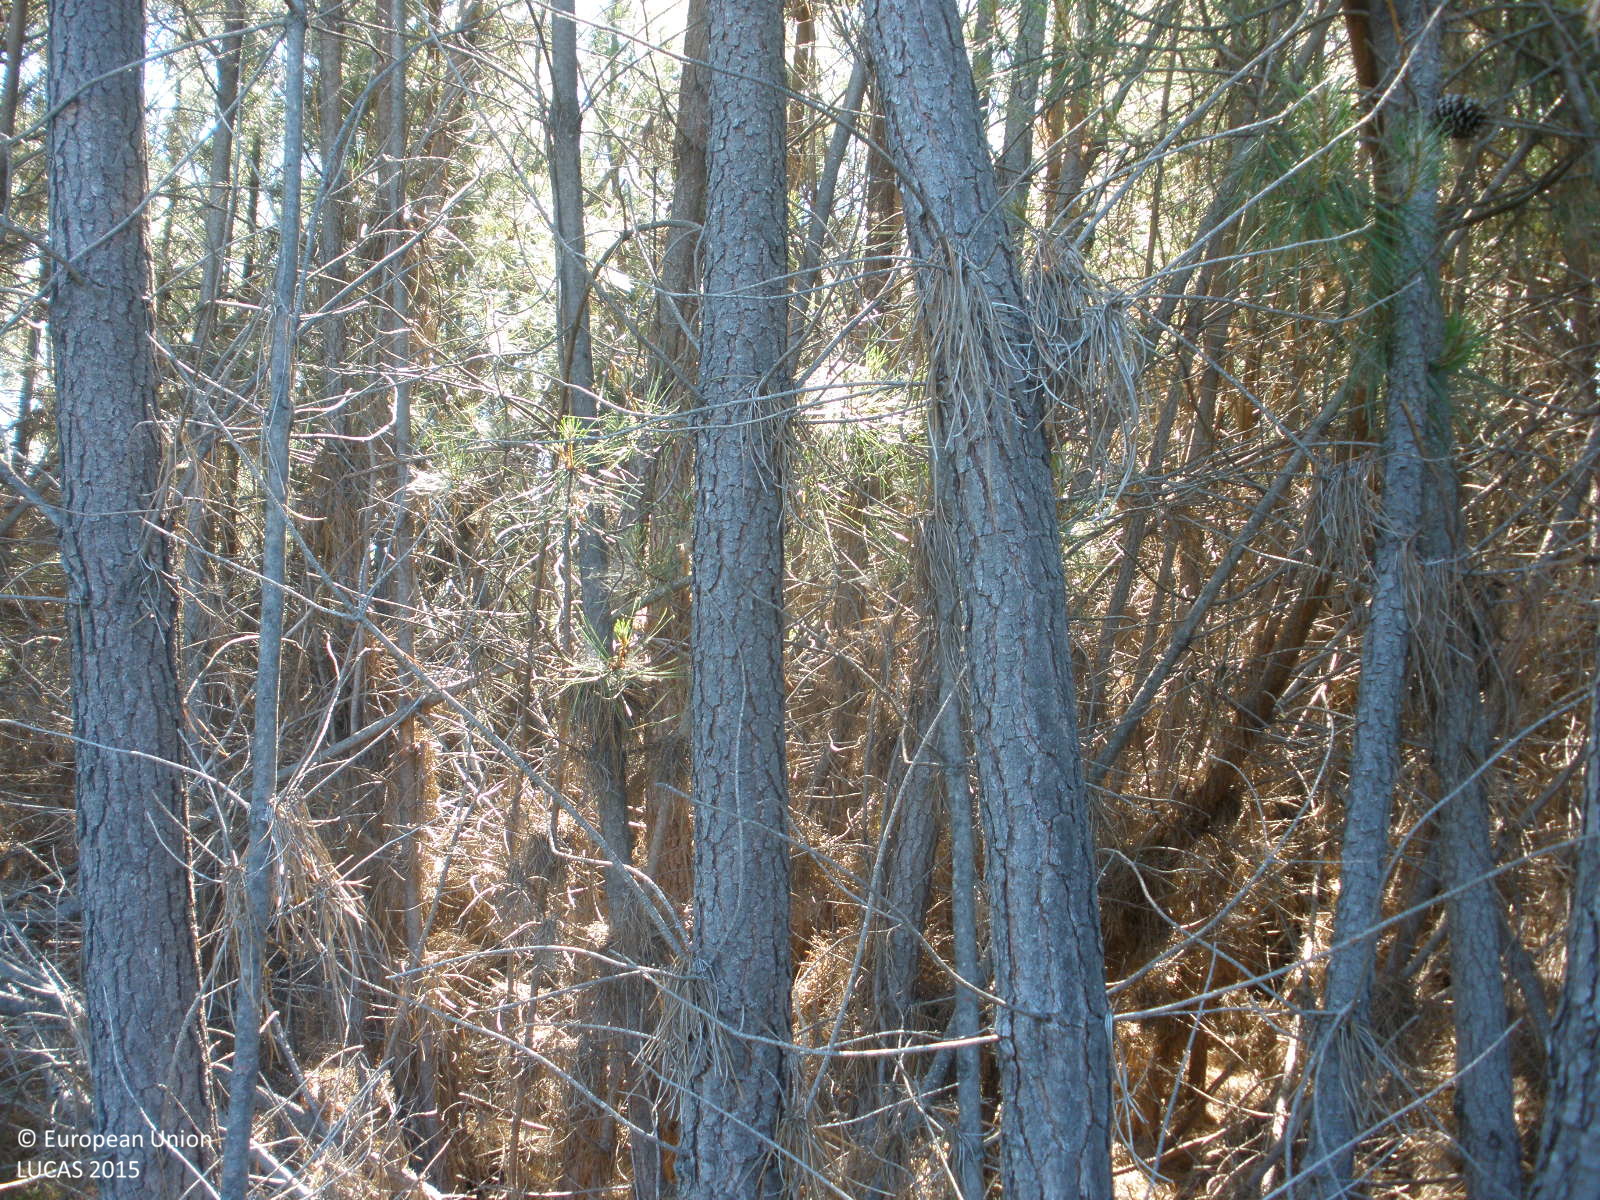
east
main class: Woodland
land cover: Pine dominated coniferous woodland
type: coniferous forest of the mediterranean region
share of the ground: > 75 %
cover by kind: coniferous forest trees 90 %, shrubs 10 %
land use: Forestry
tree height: > 5 m
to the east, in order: Pine dominated coniferous woodland; Shrubland without tree cover; Tracks; Shrubland with sparse tree cover; Permanent crops (only in case pi); Broadleaved woodland; Grassland without tree/shrub cover; Electric lines; Grassland without tree/shrub cover; Tracks; Pine dominated coniferous woodland
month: May
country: ES
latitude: 40.2106
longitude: -6.5688
